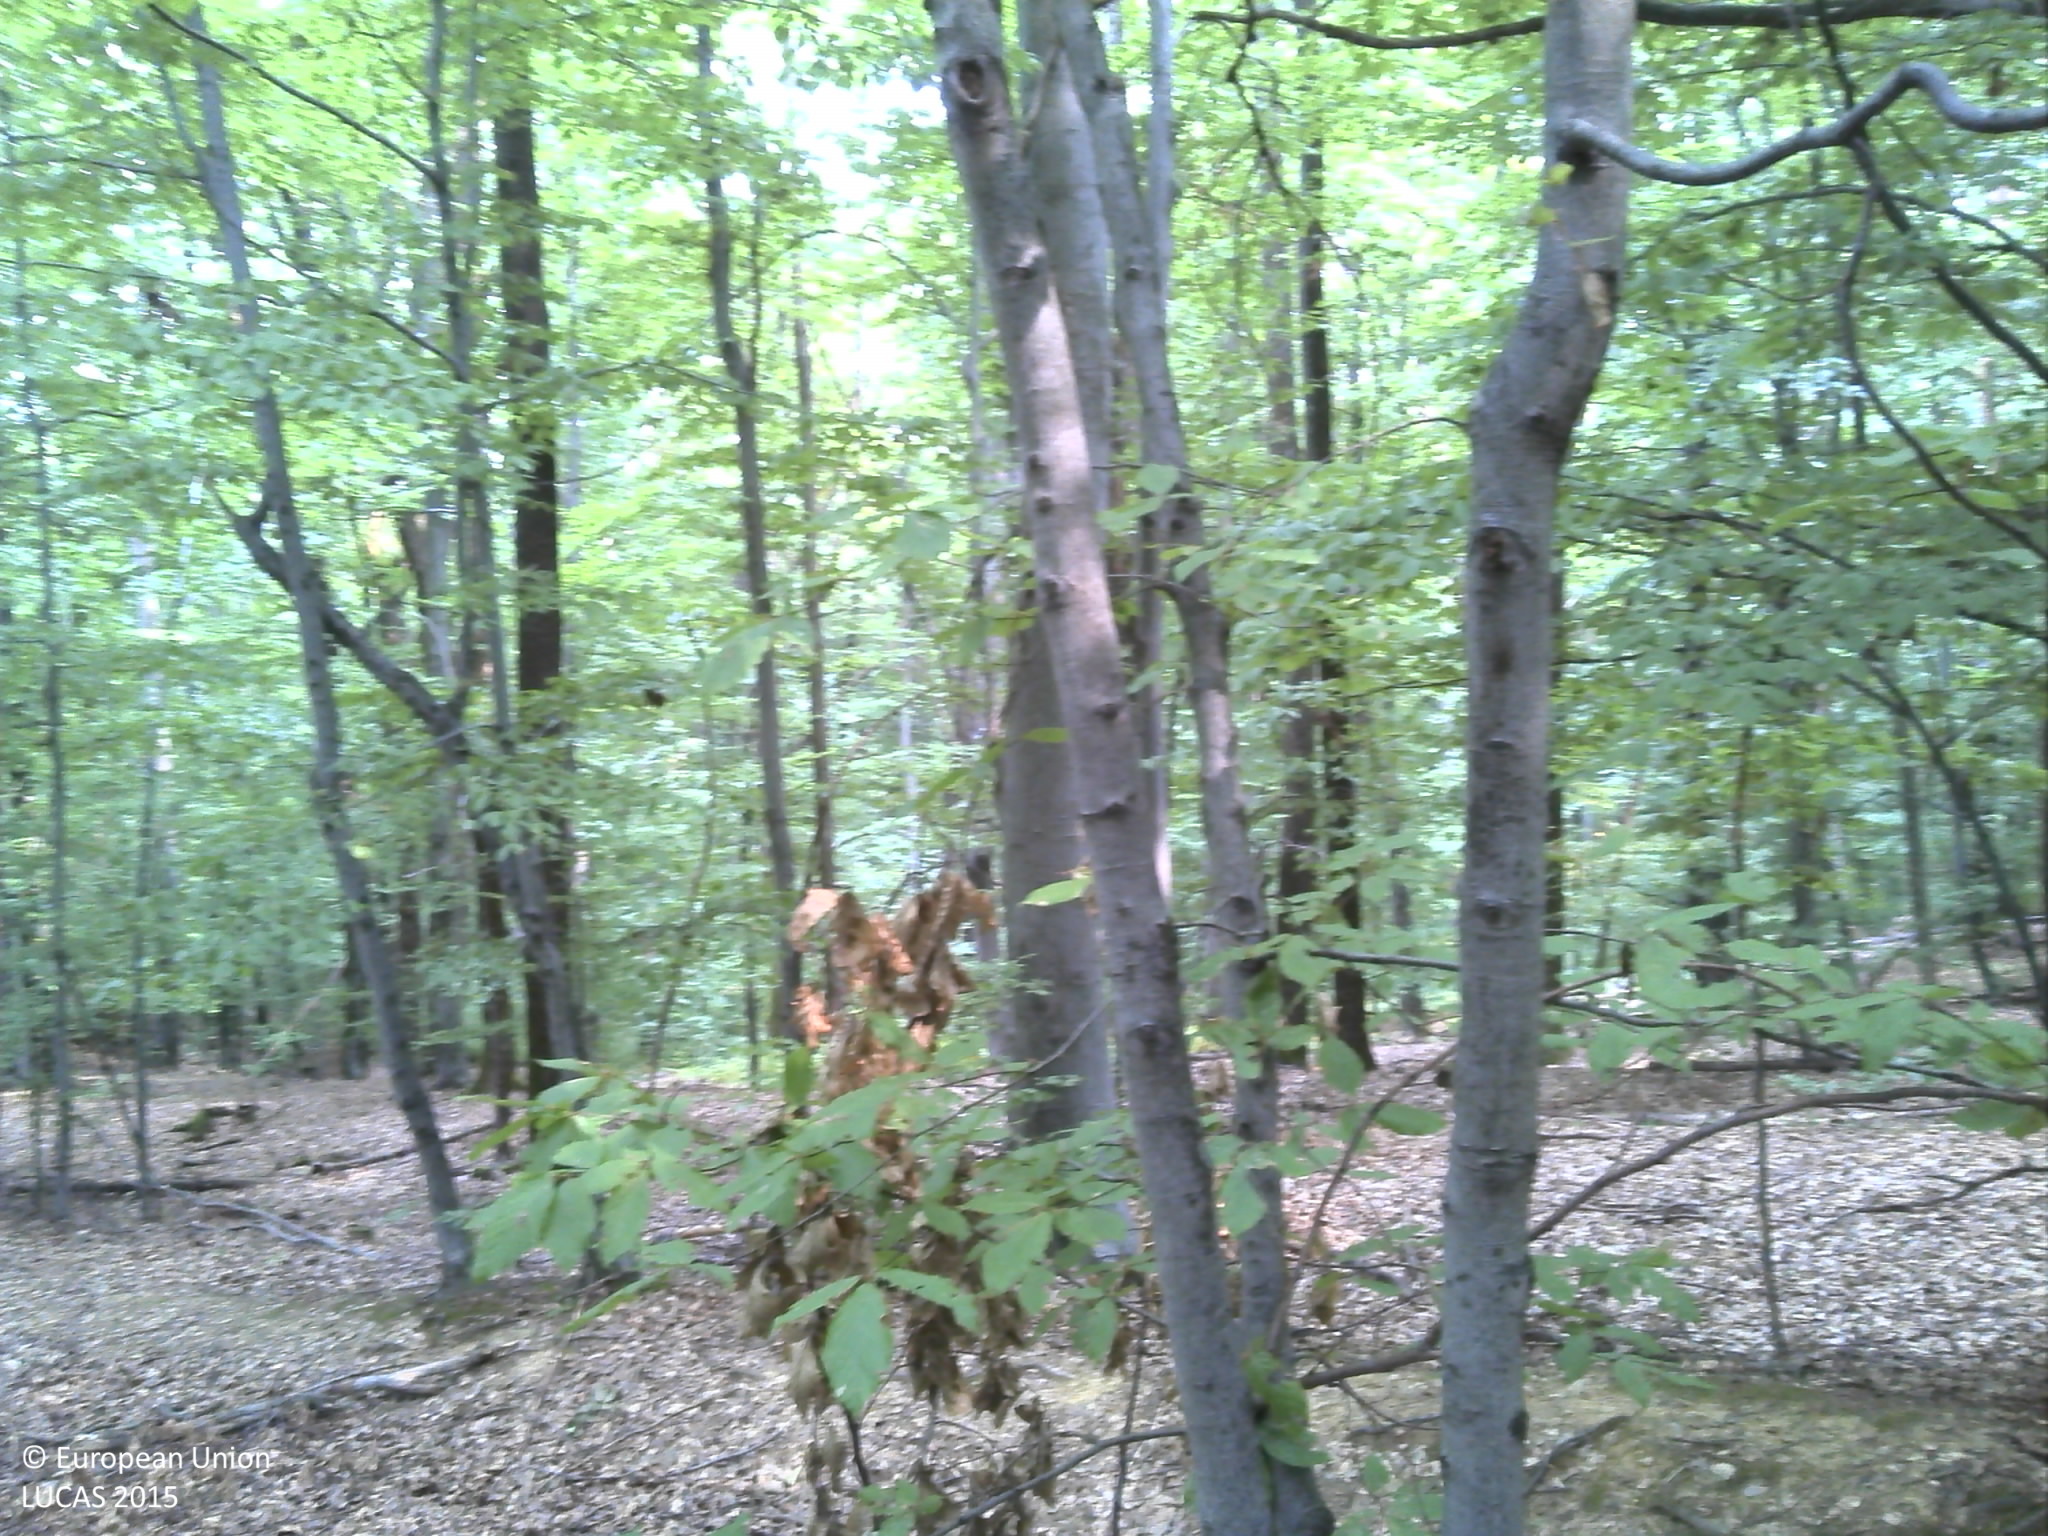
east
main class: Woodland
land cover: Broadleaved woodland
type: acidophilous oak and oak-birch forest
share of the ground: > 75 %
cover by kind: broadleaved forest trees 100 %
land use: Forestry
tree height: > 5 m
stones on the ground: < 10 %
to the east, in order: Broadleaved woodland
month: August
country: HR
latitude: 45.4959
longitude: 17.9245
